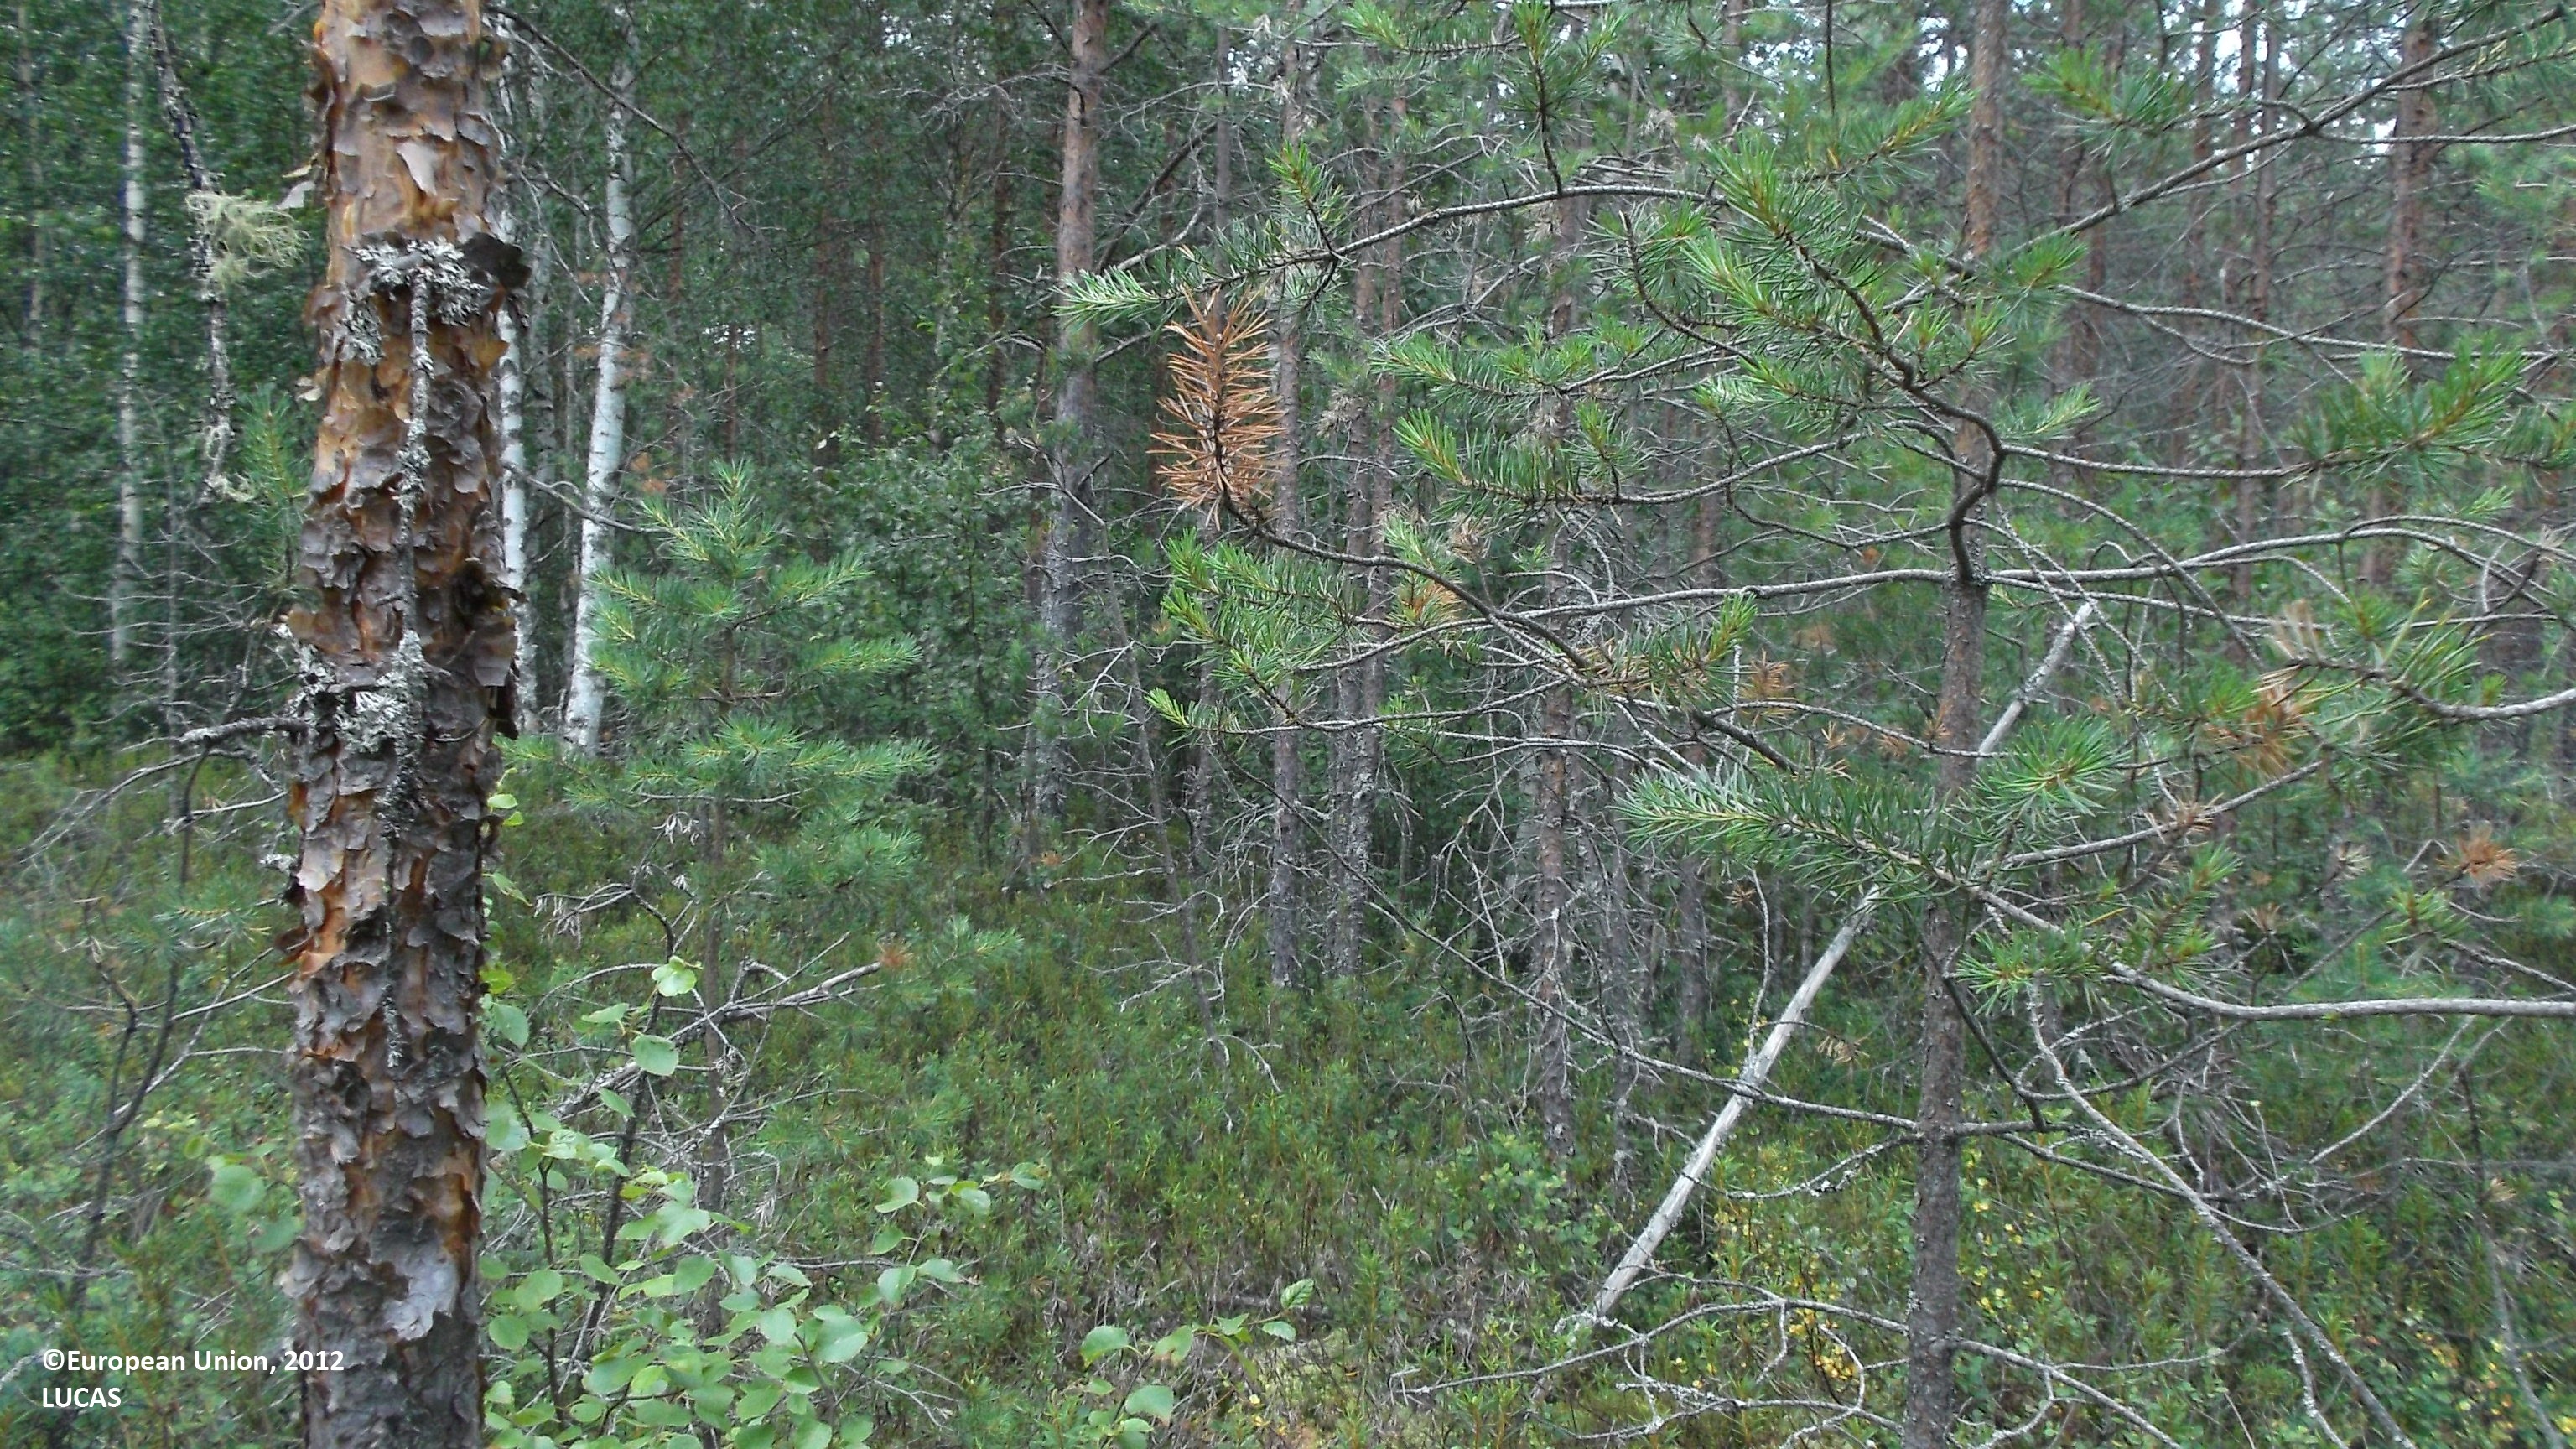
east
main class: Woodland
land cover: Pine dominated coniferous woodland
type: mire and swamp forests
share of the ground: 25 - 50 %
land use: Forestry
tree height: < 5 m
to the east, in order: Pine dominated coniferous woodland; Ditches and canals; Pine dominated mixed woodland; Other mixed woodland; Ditches and canals; Other mixed woodland; Pine dominated mixed woodland; Pine dominated coniferous woodland
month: July
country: FI
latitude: 63.5470
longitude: 23.2365
